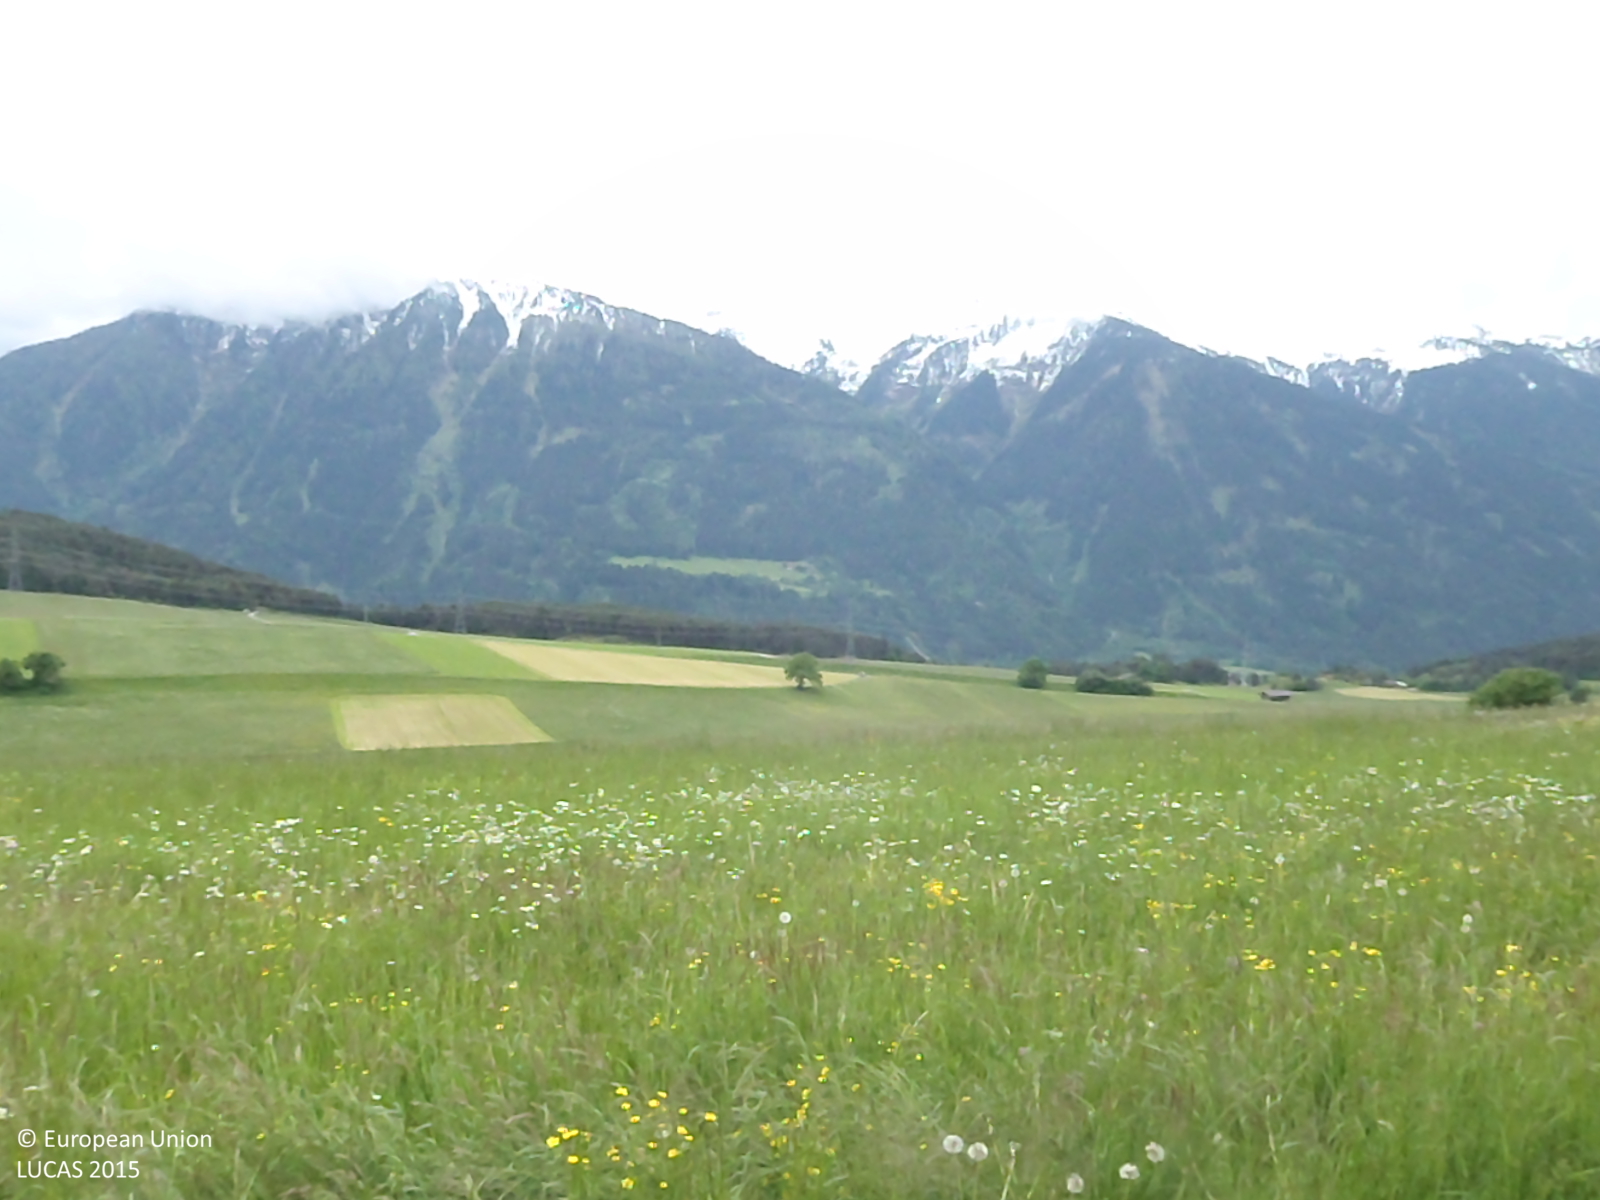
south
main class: Grassland
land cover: Grassland without tree/shrub cover
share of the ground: > 75 %
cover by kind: herbaceous plants 100 %
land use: Agriculture (excluding fallow land and kitchen gardens)
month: May
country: AT
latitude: 47.3011
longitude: 10.9910
